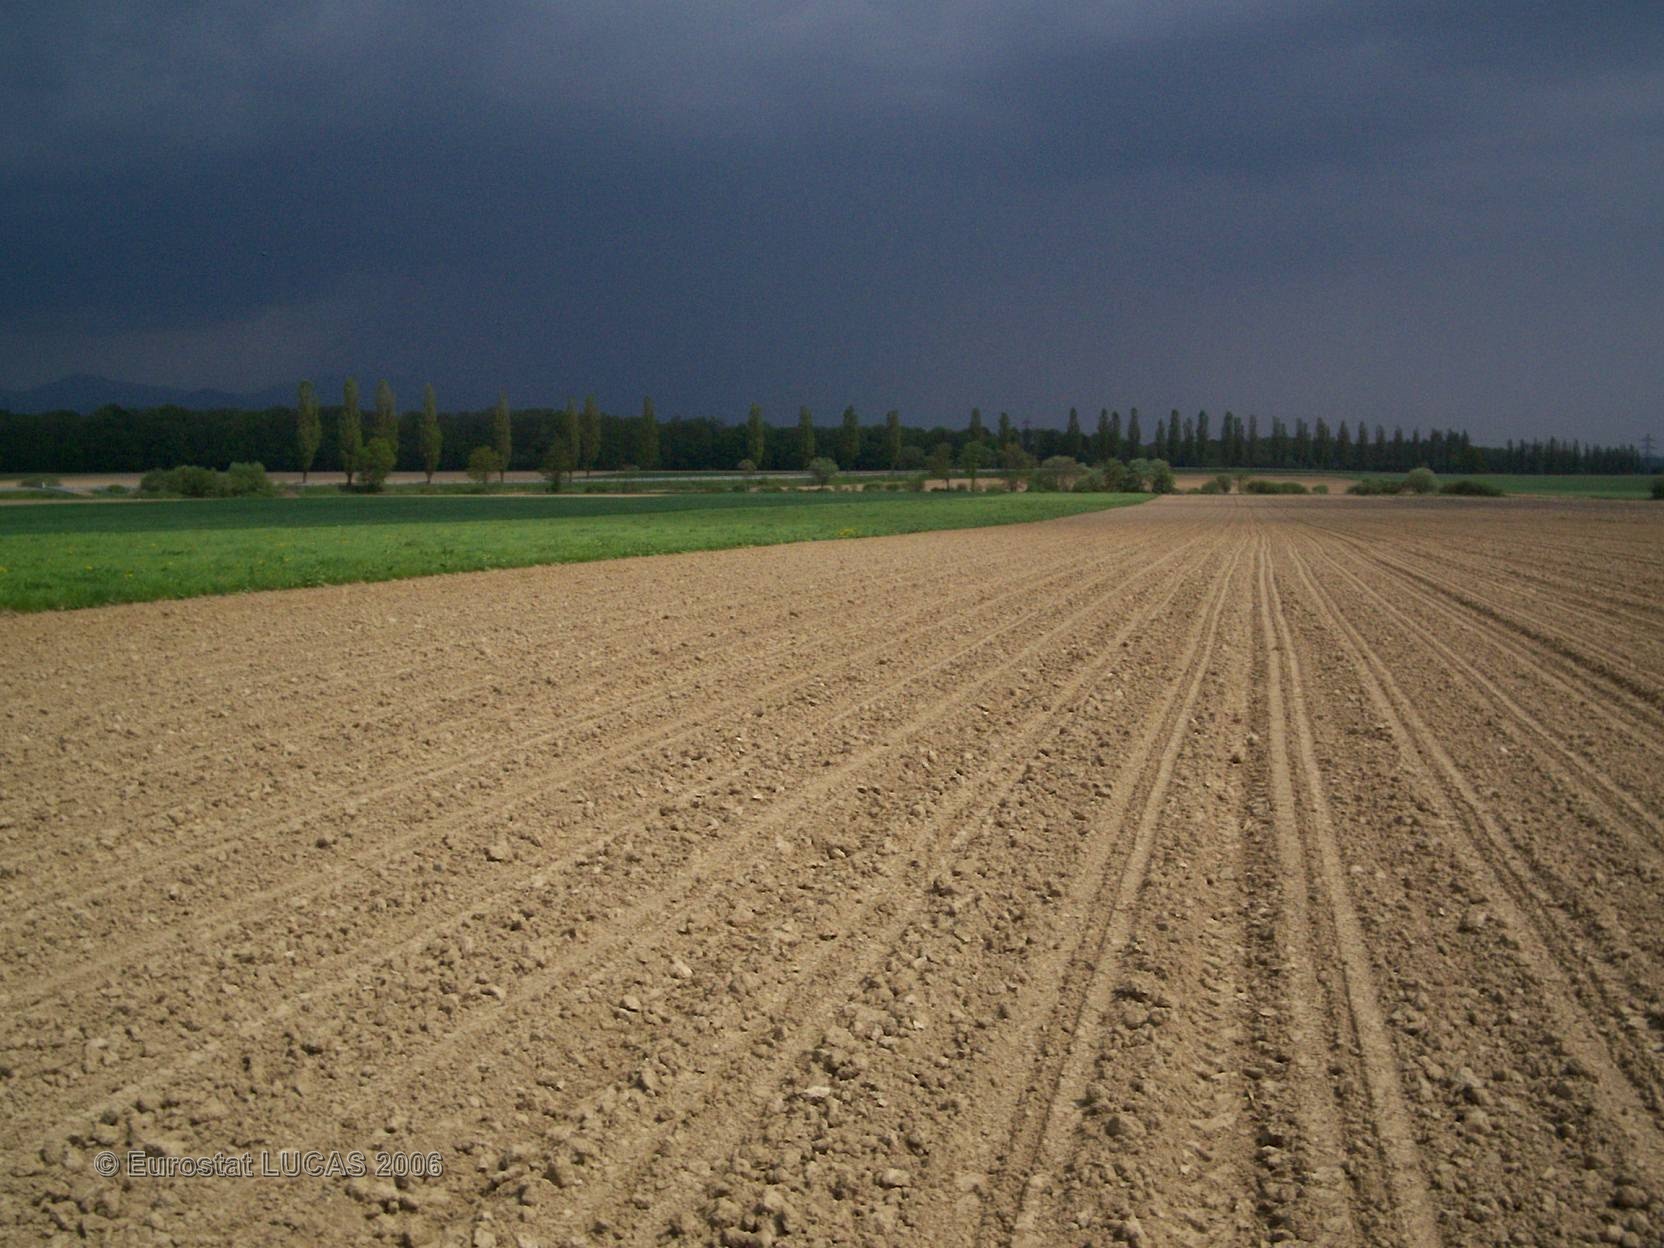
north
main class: Cropland
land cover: Maize
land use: Agriculture (excluding fallow land and kitchen gardens)
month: May
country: FR
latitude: 47.7174
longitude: 7.1088
